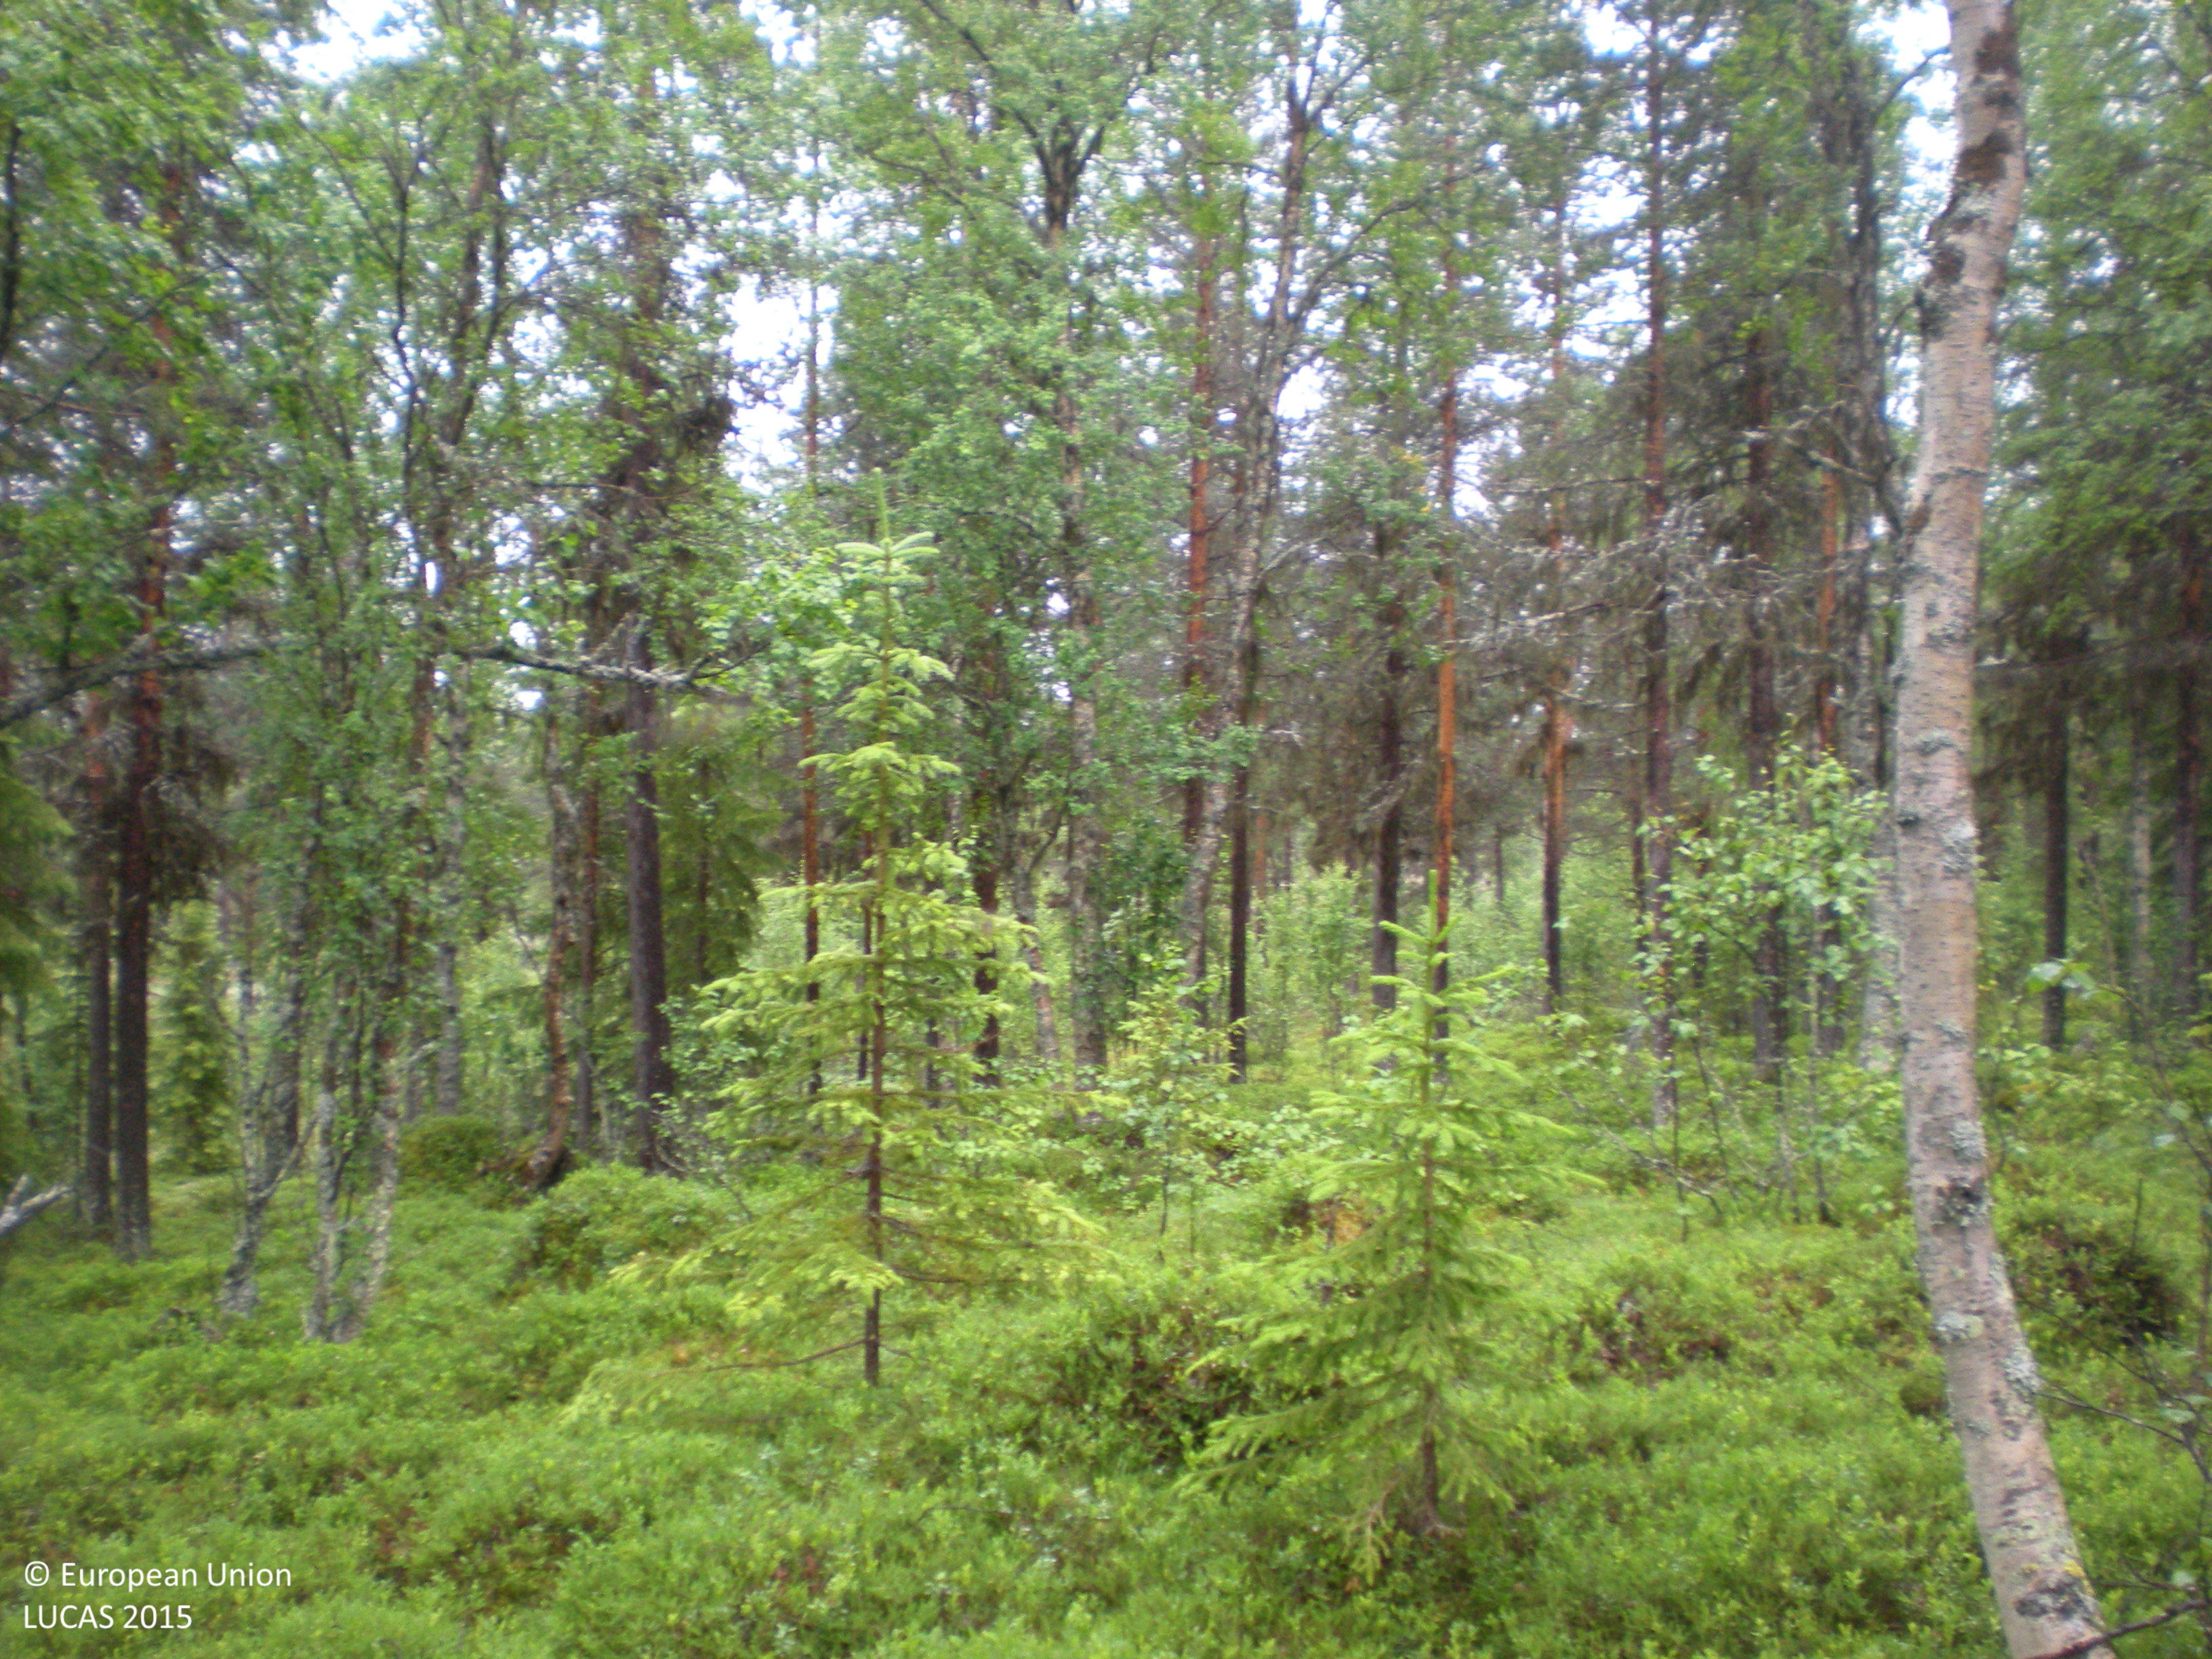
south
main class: Woodland
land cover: Pine dominated mixed woodland
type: boreal forest
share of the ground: 50 - 75 %
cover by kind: coniferous forest trees 40 %, broadleaved forest trees 25 %, shrubs 25 %, herbaceous plants 5 %, lichens and mosses 5 %
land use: Forestry
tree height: > 5 m
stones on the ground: 25 - 50 %
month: July
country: SE
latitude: 66.0078
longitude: 18.1323
